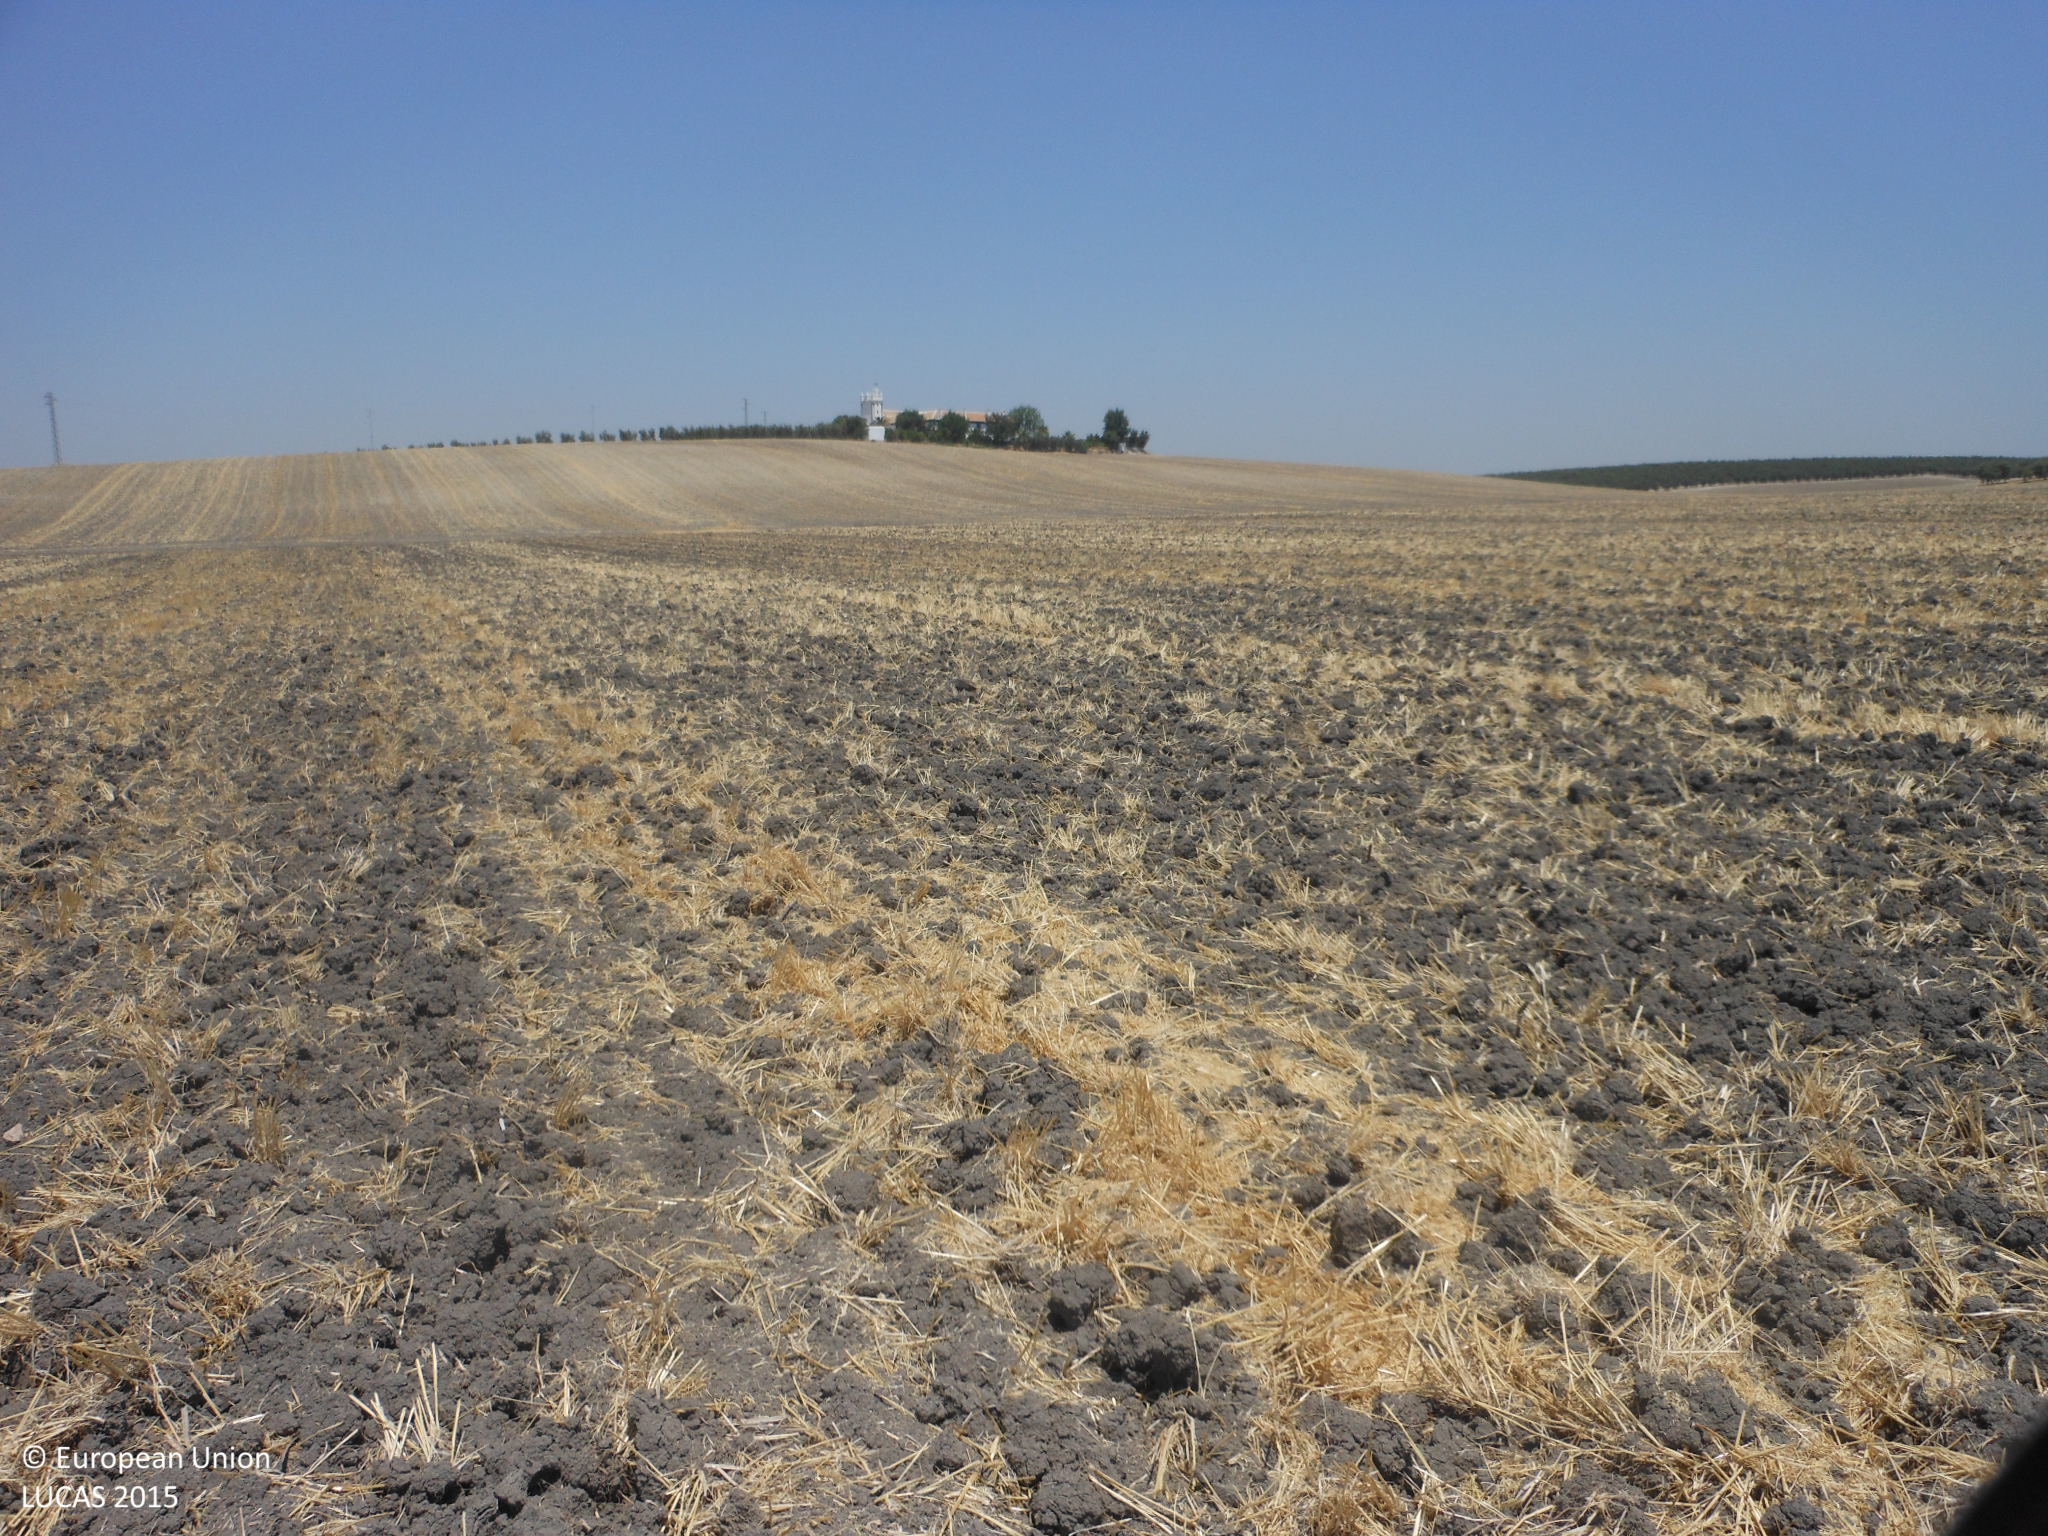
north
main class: Cropland
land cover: Common wheat
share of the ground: < 10 %
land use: Agriculture (excluding fallow land and kitchen gardens)
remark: Harvested field
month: June
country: ES
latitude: 37.1297
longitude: -5.5110
